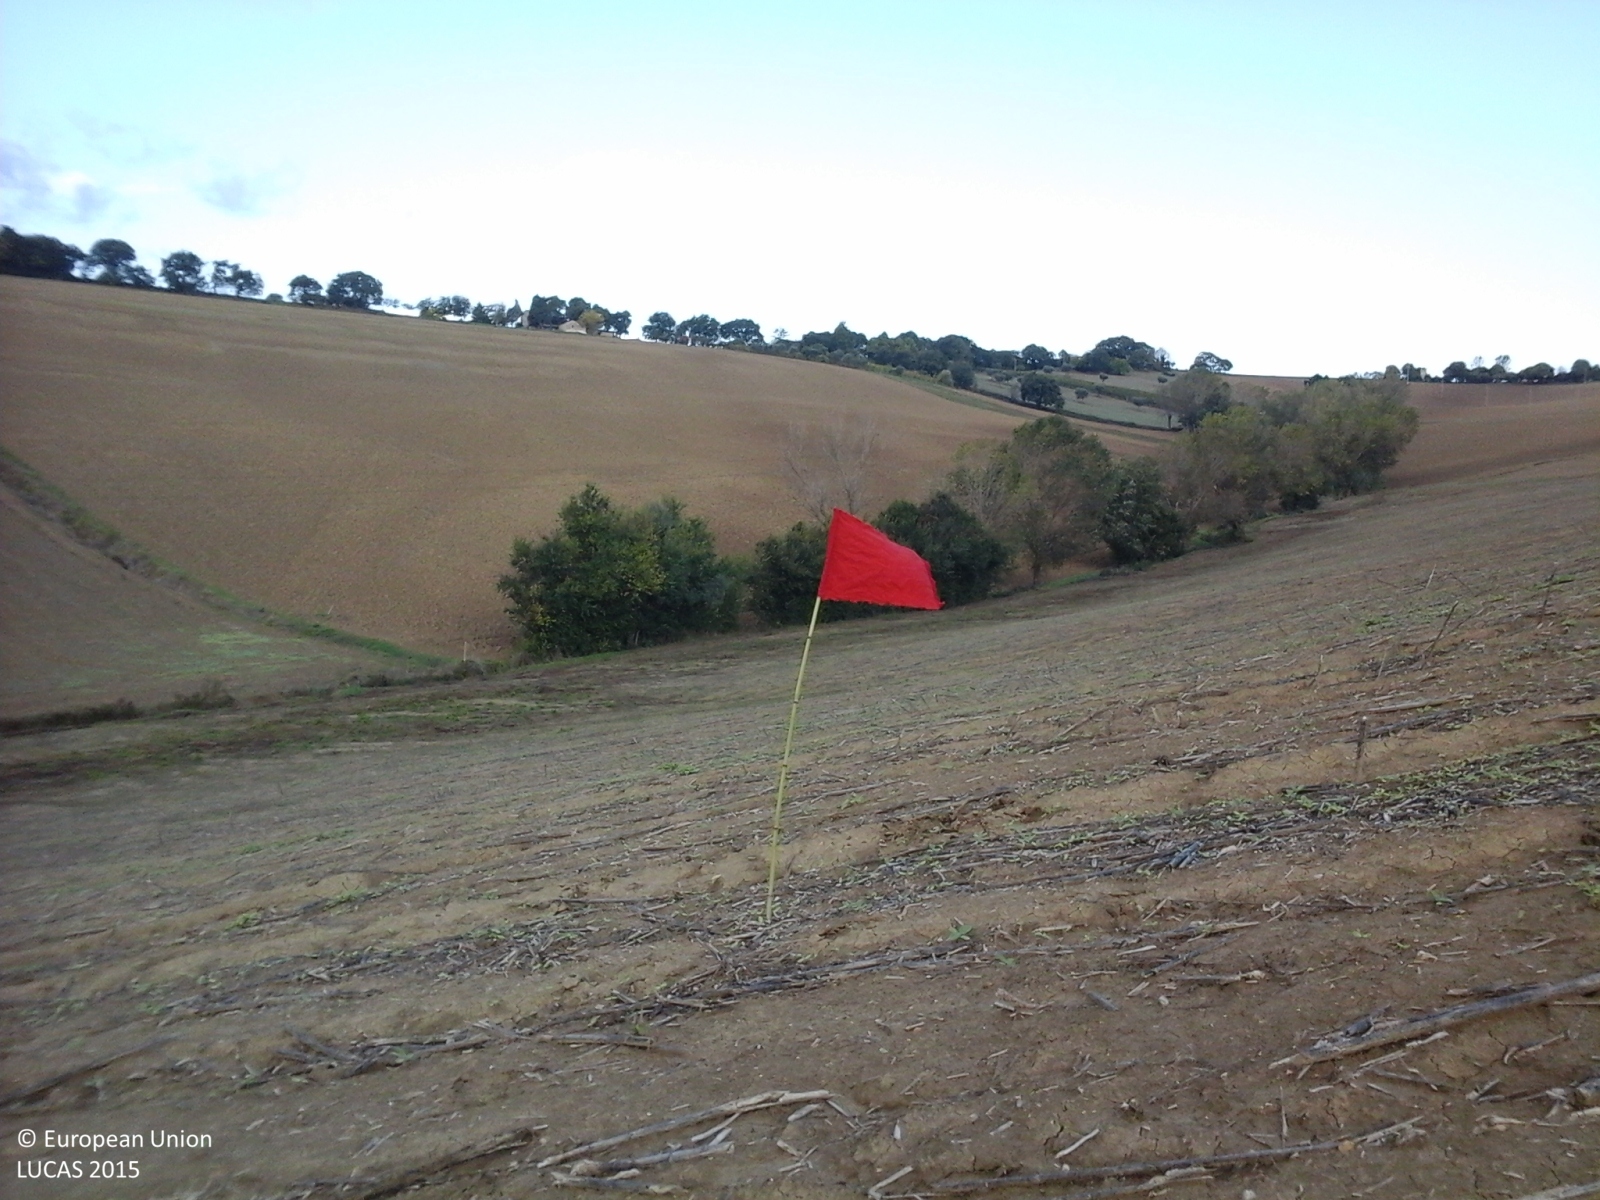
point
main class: Cropland
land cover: Sunflower
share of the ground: < 10 %
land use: Agriculture (excluding fallow land and kitchen gardens)
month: October
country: IT
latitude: 43.6332
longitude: 13.2025
